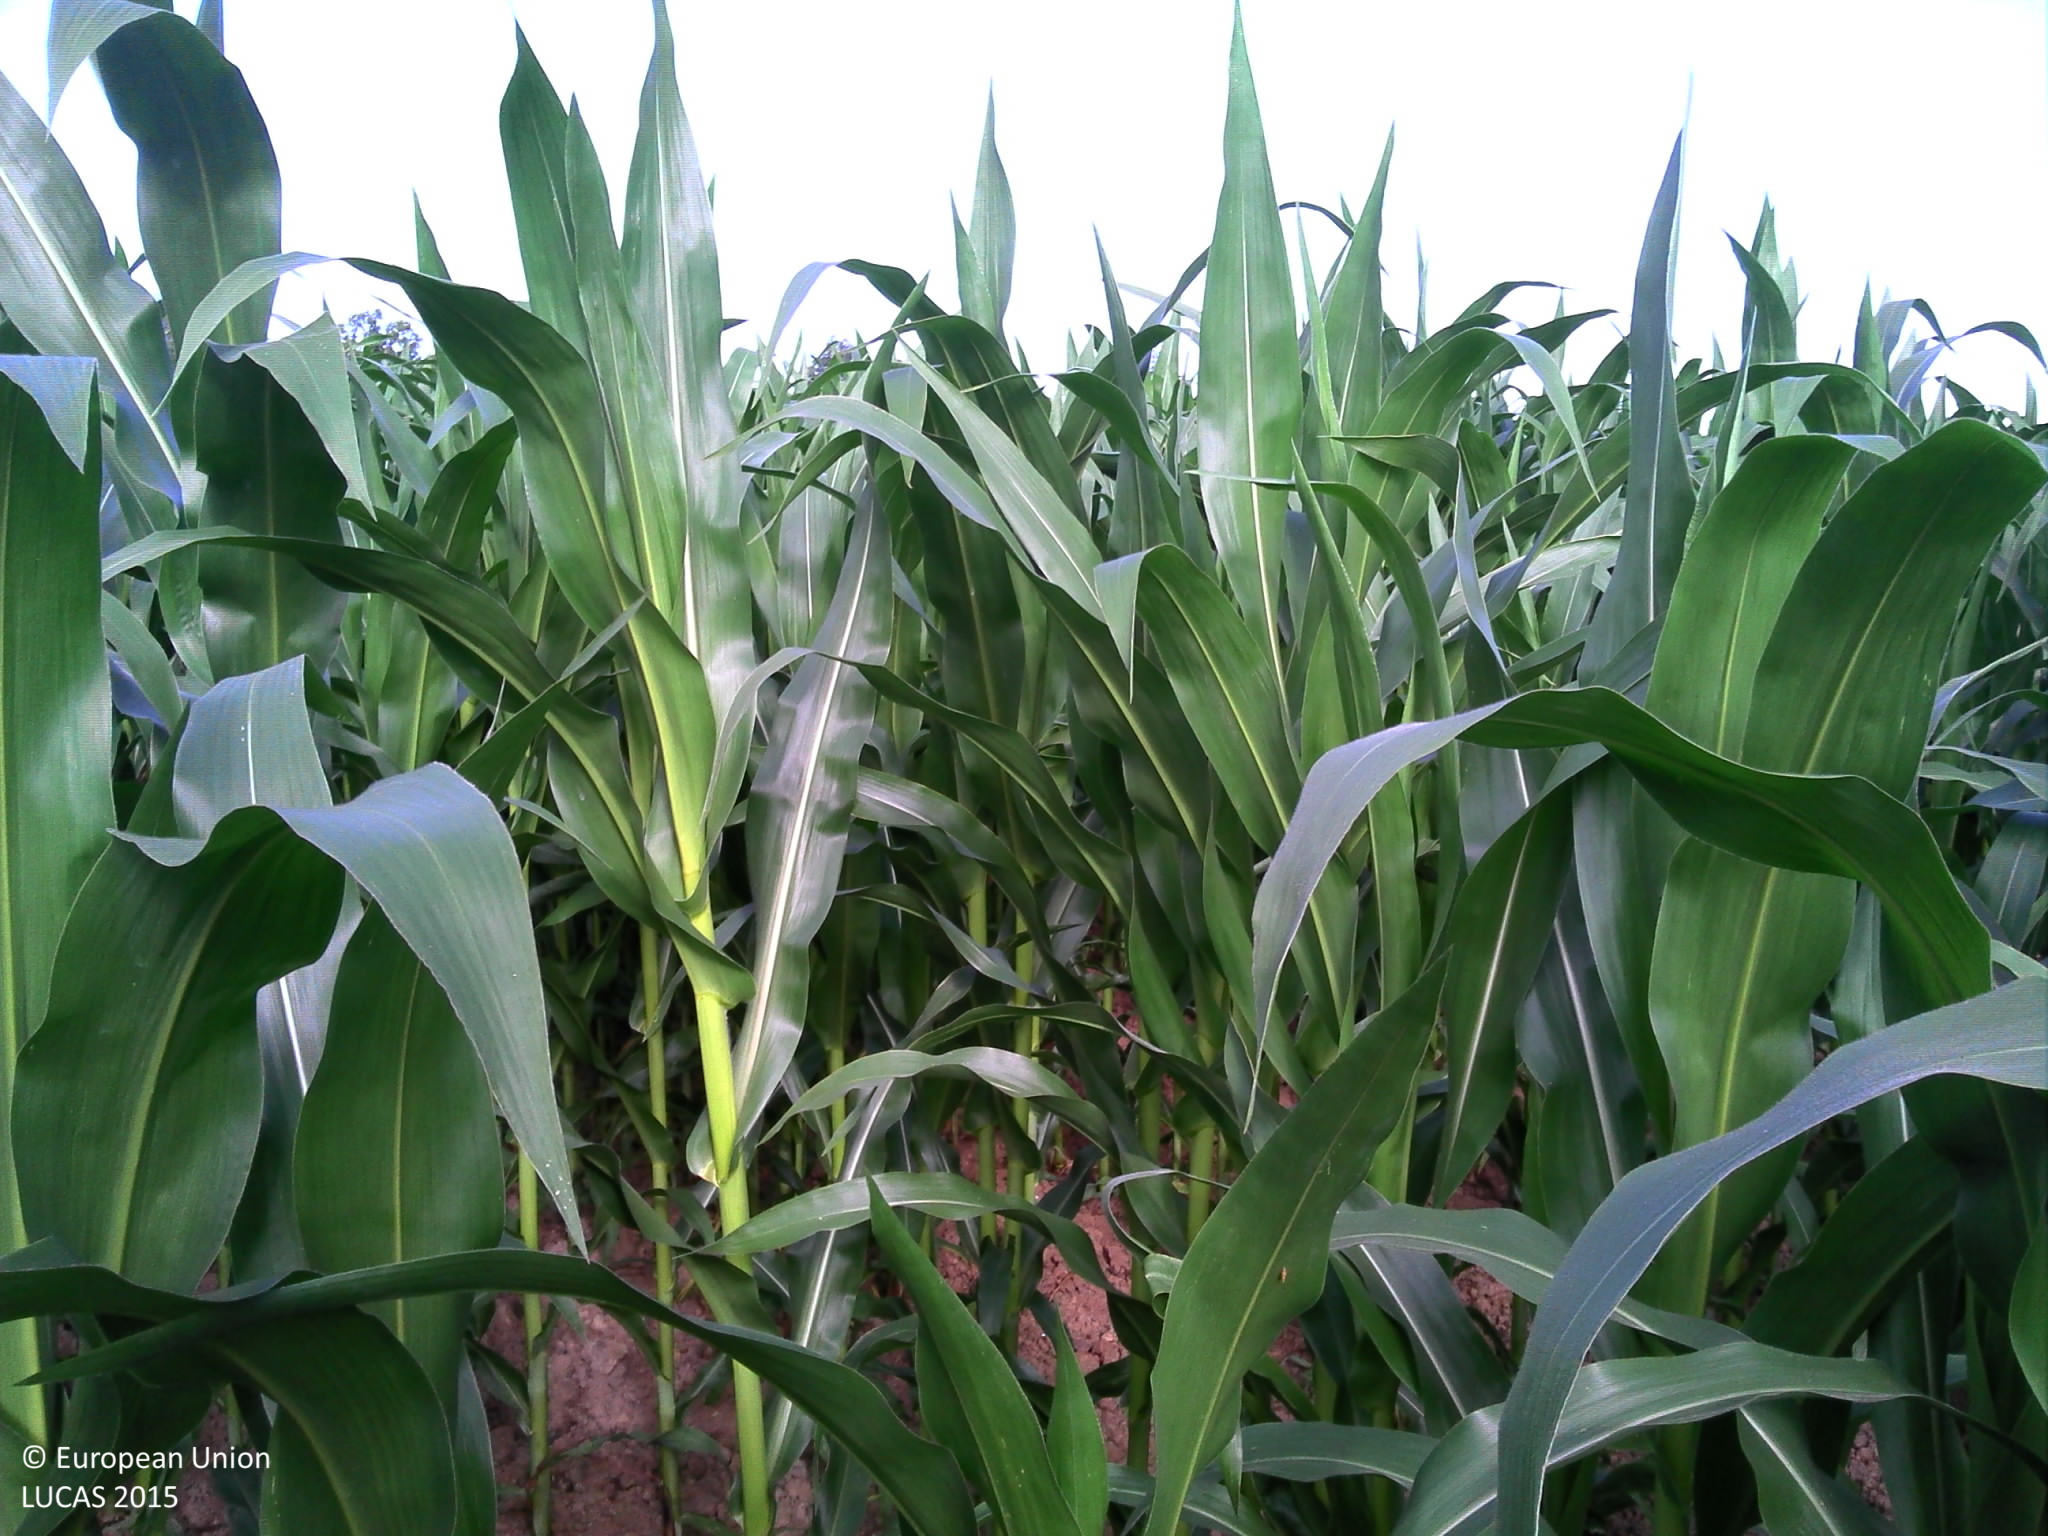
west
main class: Cropland
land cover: Maize
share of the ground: > 75 %
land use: Agriculture (excluding fallow land and kitchen gardens)
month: July
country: BE
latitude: 49.6853
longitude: 5.6048
